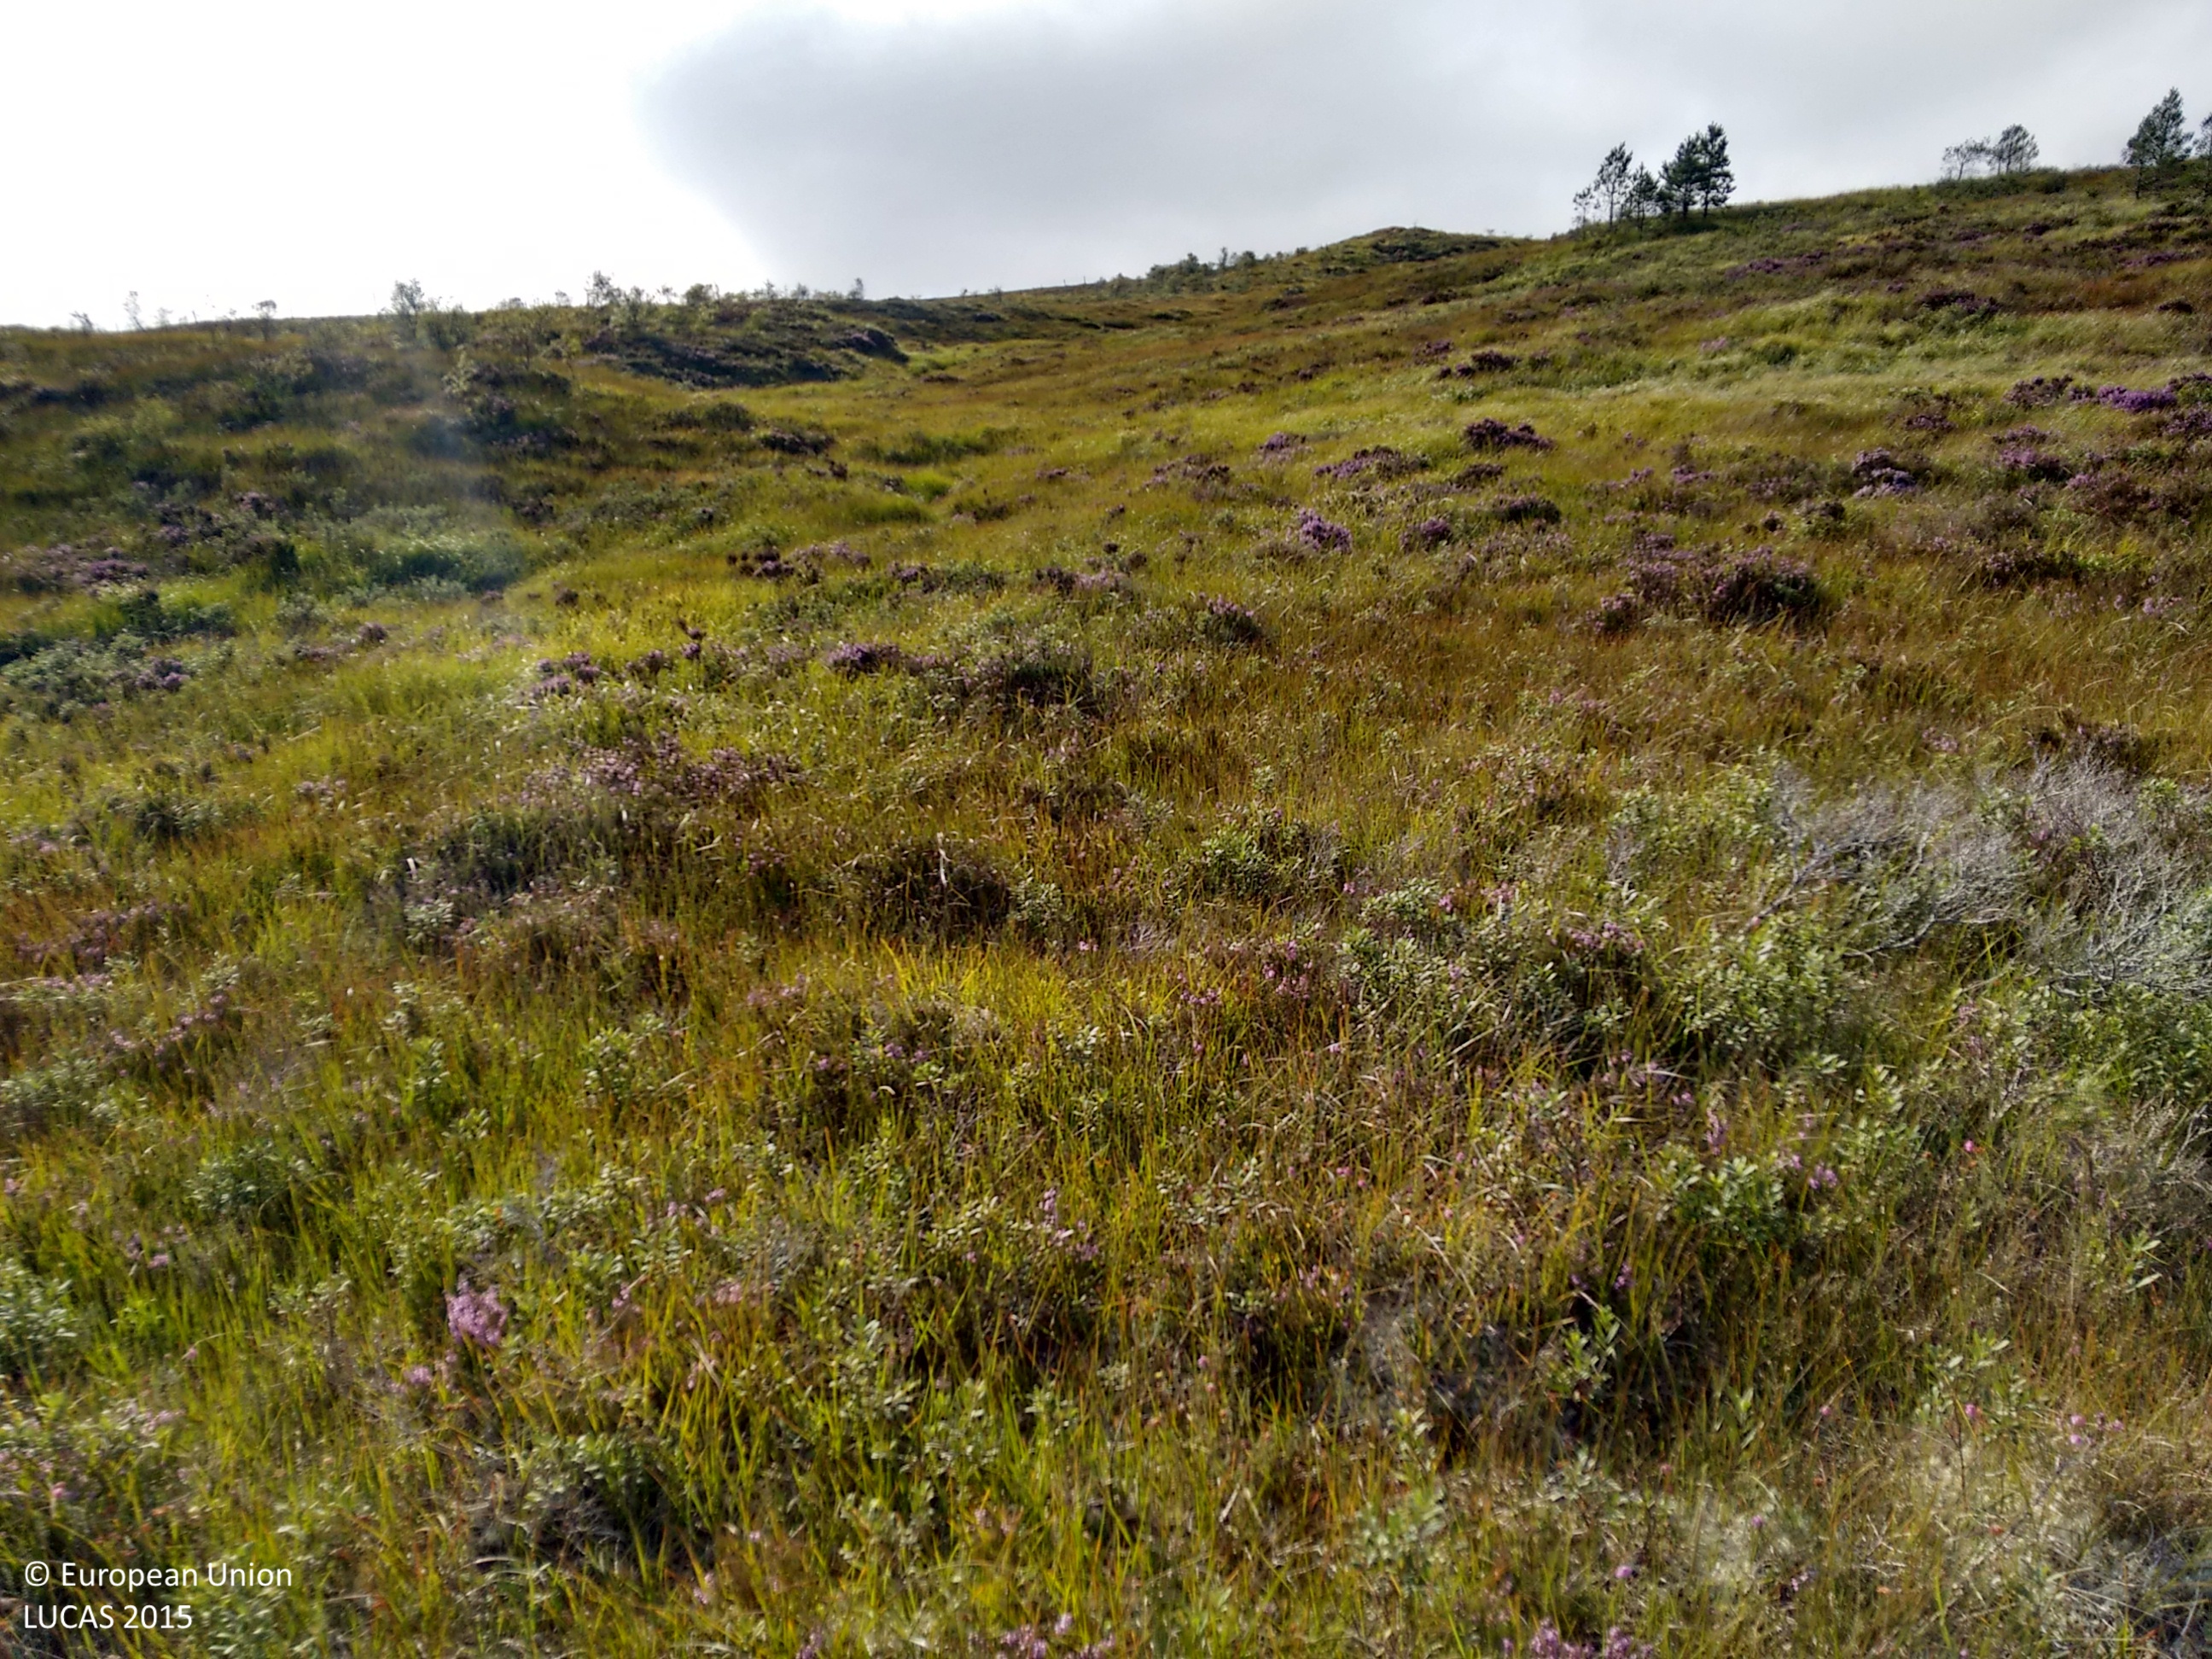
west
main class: Shrubland
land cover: Shrubland with sparse tree cover
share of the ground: > 75 %
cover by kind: shrubs 60 %, herbaceous plants 35 %, broadleaved forest trees 5 %
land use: Forestry
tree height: < 5 m
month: September
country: GB
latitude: 58.2147
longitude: -4.5040
